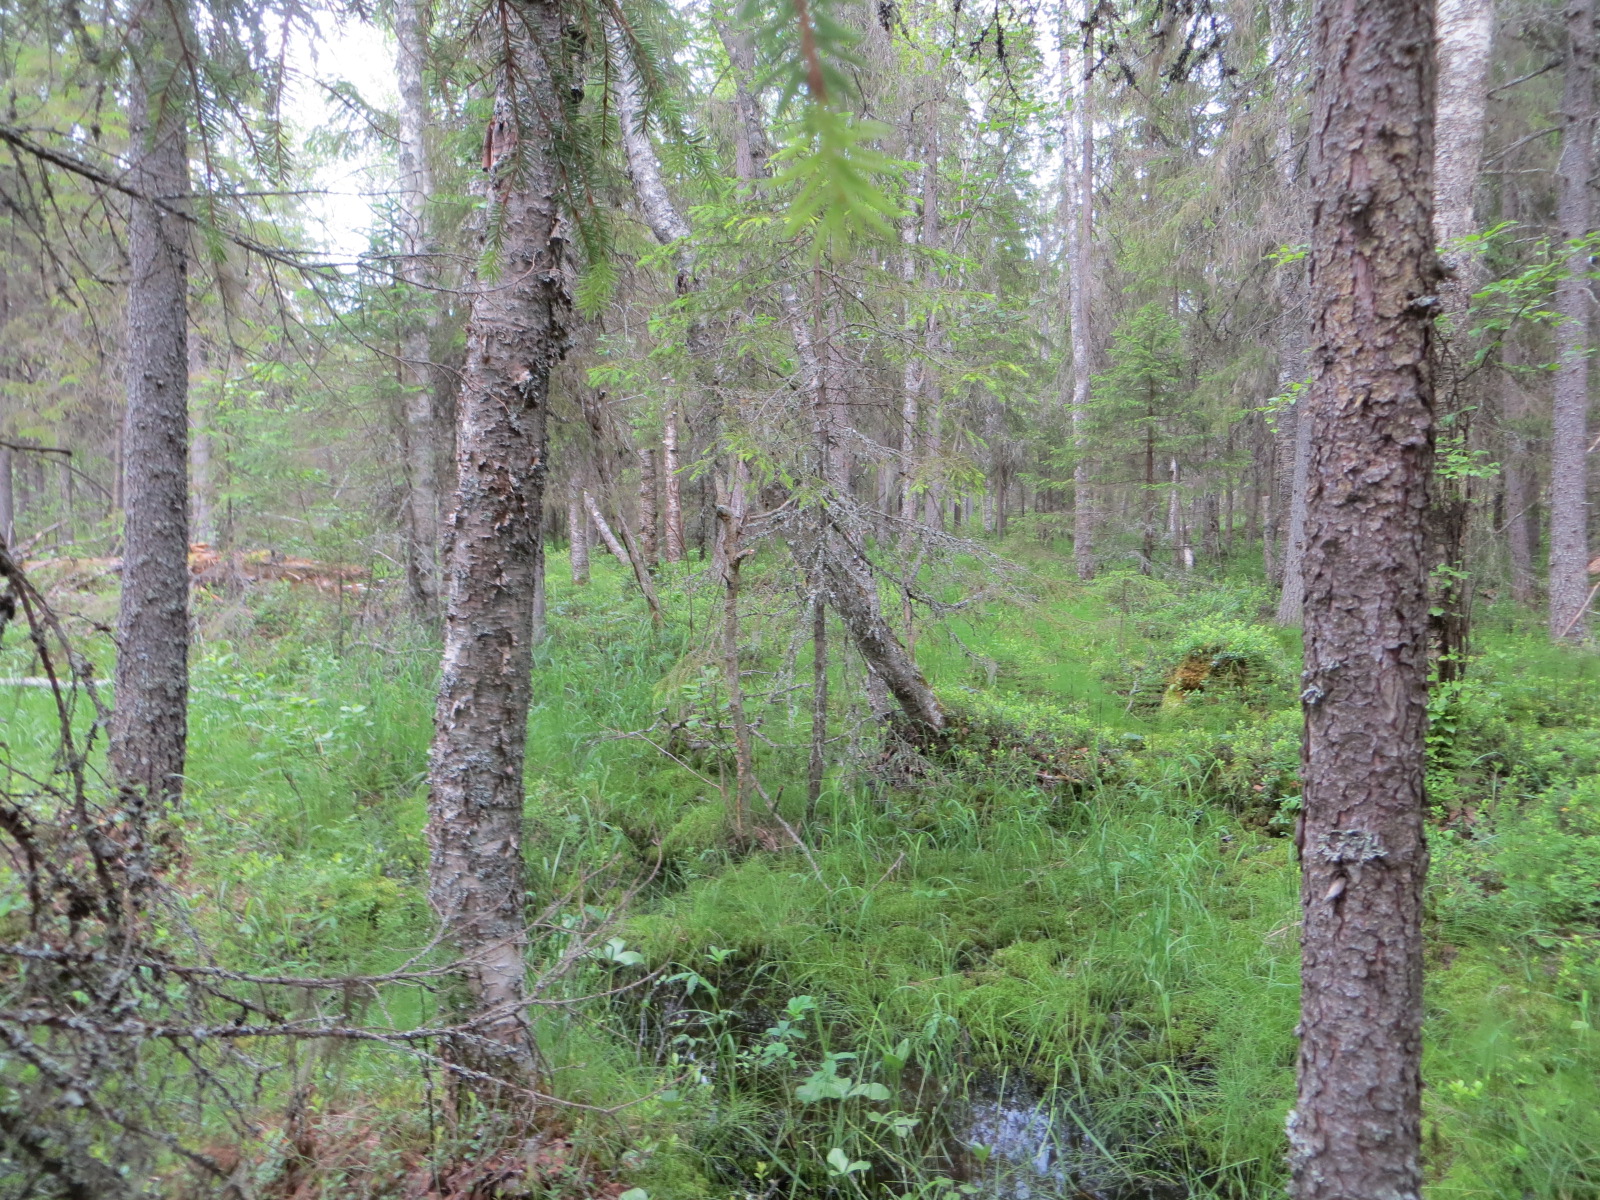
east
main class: Woodland
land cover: Spruce dominated mixed woodland
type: mire and swamp forests
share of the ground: 50 - 75 %
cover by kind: coniferous forest trees 40 %, broadleaved forest trees 30 %, shrubs 25 %, lichens and mosses 5 %
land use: Forestry
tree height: > 5 m
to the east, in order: Spruce dominated mixed woodland; Pine dominated coniferous woodland; Spruce dominated mixed woodland; Other mixed woodland; Pine dominated coniferous woodland
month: July
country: FI
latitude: 65.6092
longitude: 25.1071
